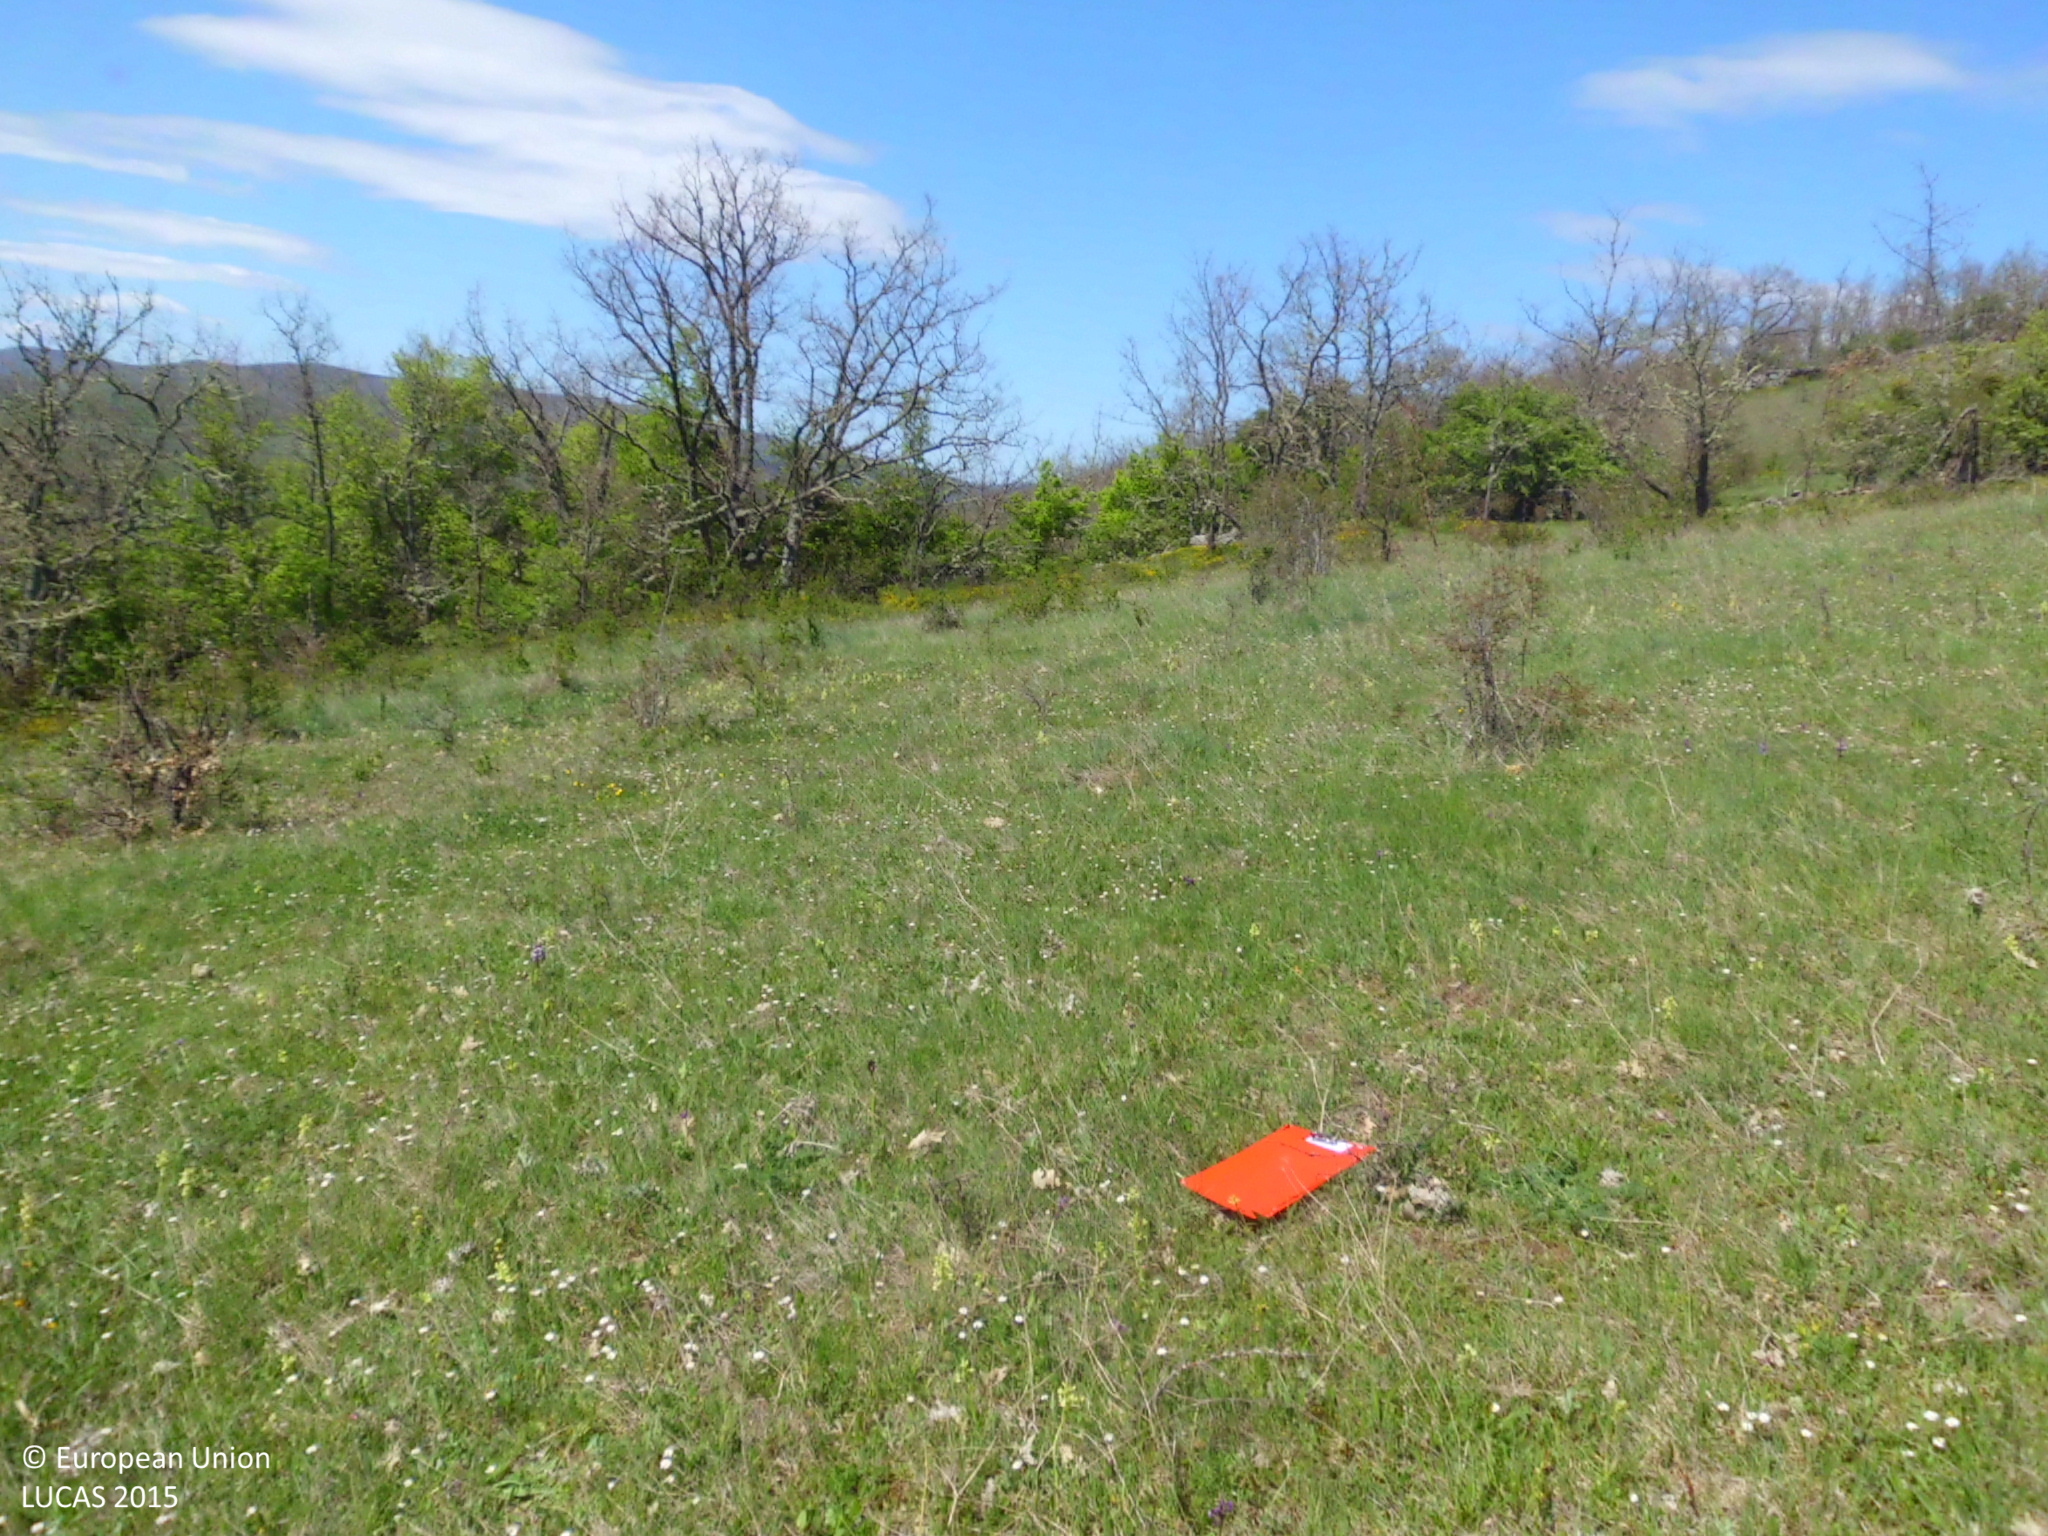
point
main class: Grassland
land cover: Grassland with sparse tree/shrub cover
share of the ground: > 75 %
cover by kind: herbaceous plants 95 %, broadleaved forest trees 5 %
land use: Abandoned areas
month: May
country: ES
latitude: 42.8429
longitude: -4.0320
